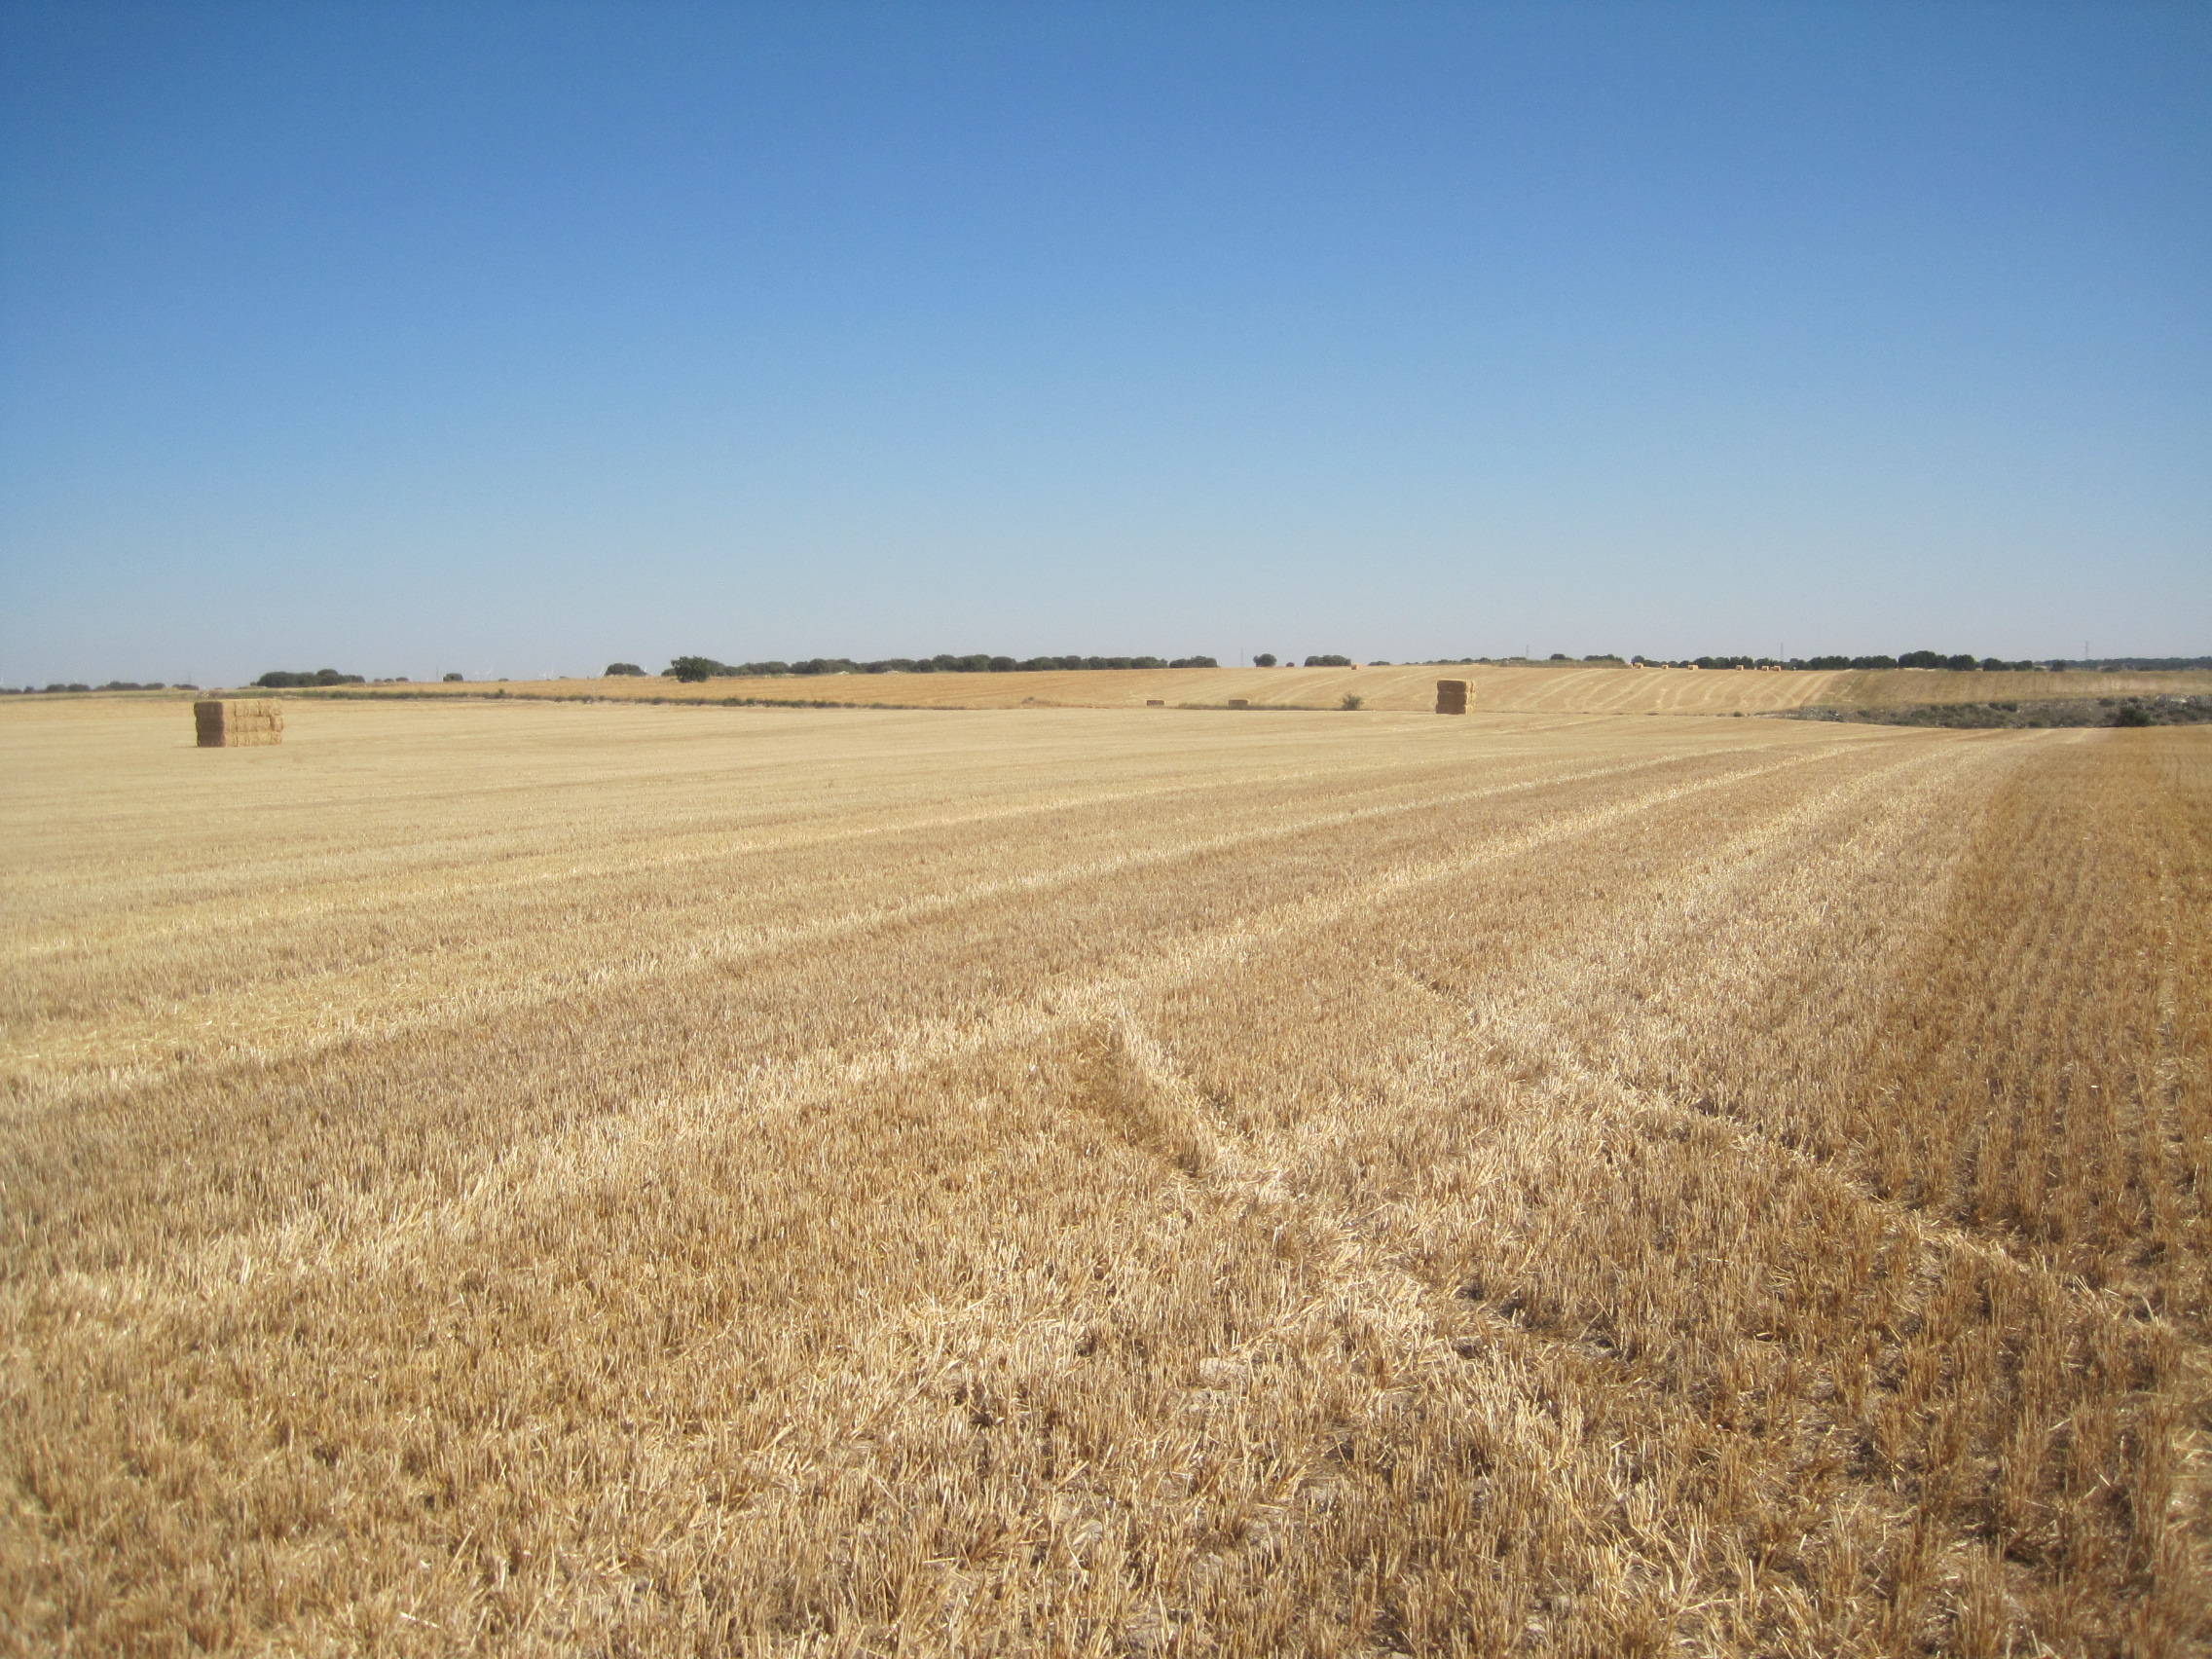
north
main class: Cropland
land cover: Barley
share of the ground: < 10 %
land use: Agriculture (excluding fallow land and kitchen gardens)
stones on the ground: < 10 %
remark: Harvested field
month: July
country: ES
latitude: 41.8524
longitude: -4.6814
